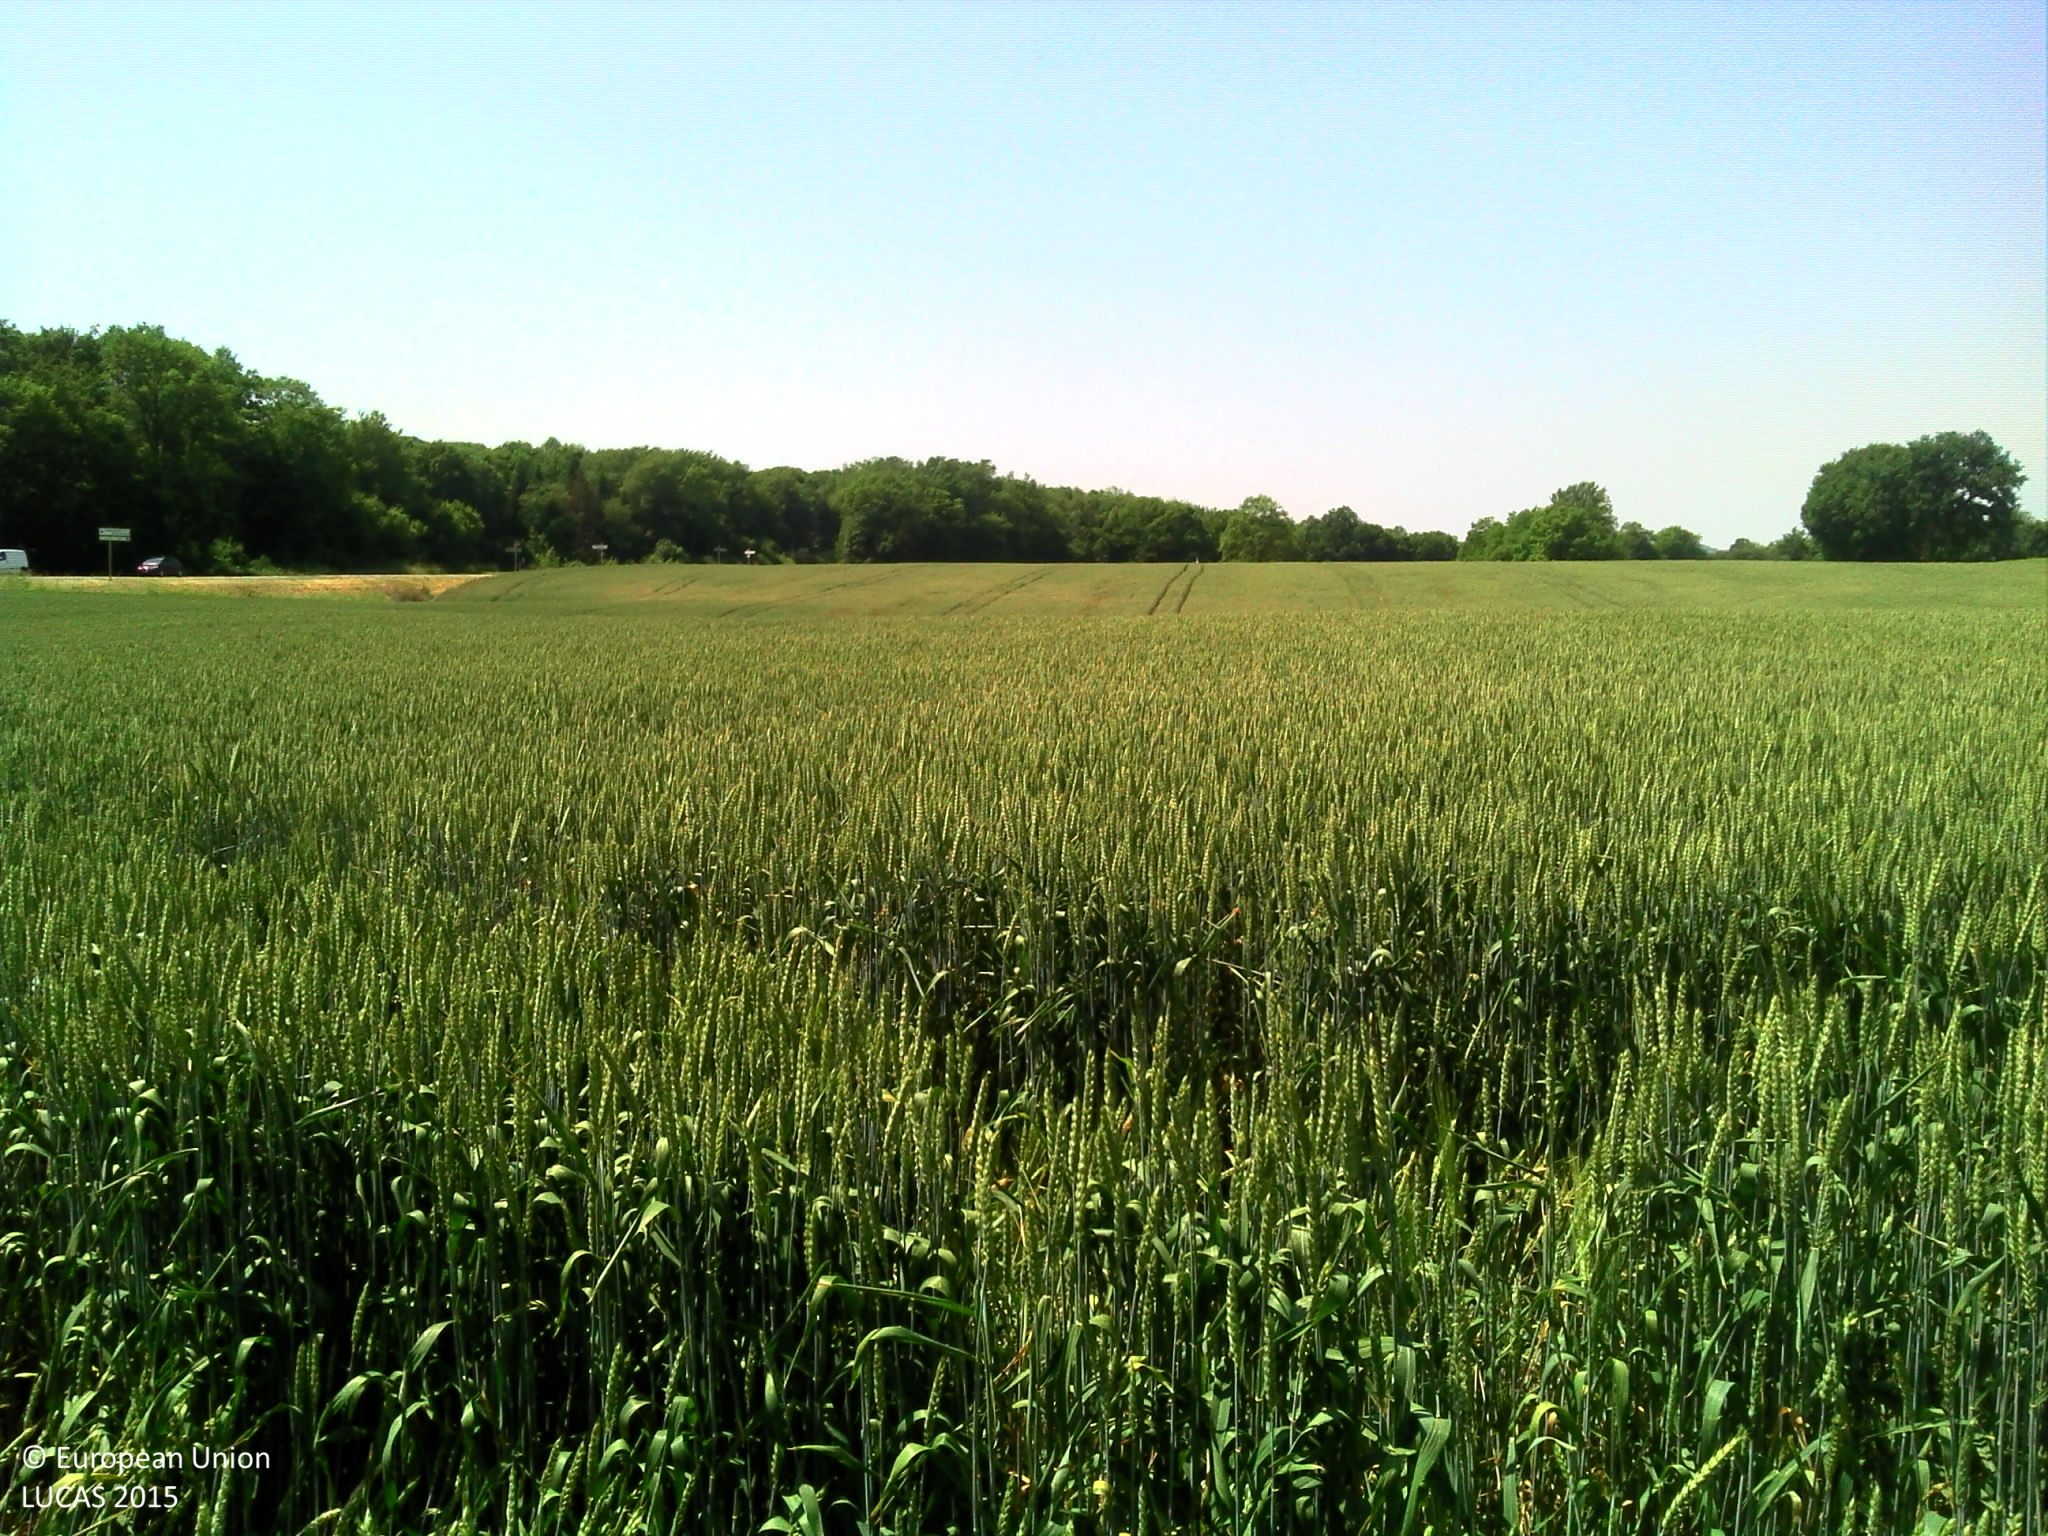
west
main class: Cropland
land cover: Common wheat
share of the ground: > 75 %
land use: Agriculture (excluding fallow land and kitchen gardens)
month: June
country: FR
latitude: 47.5829
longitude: 6.2386
